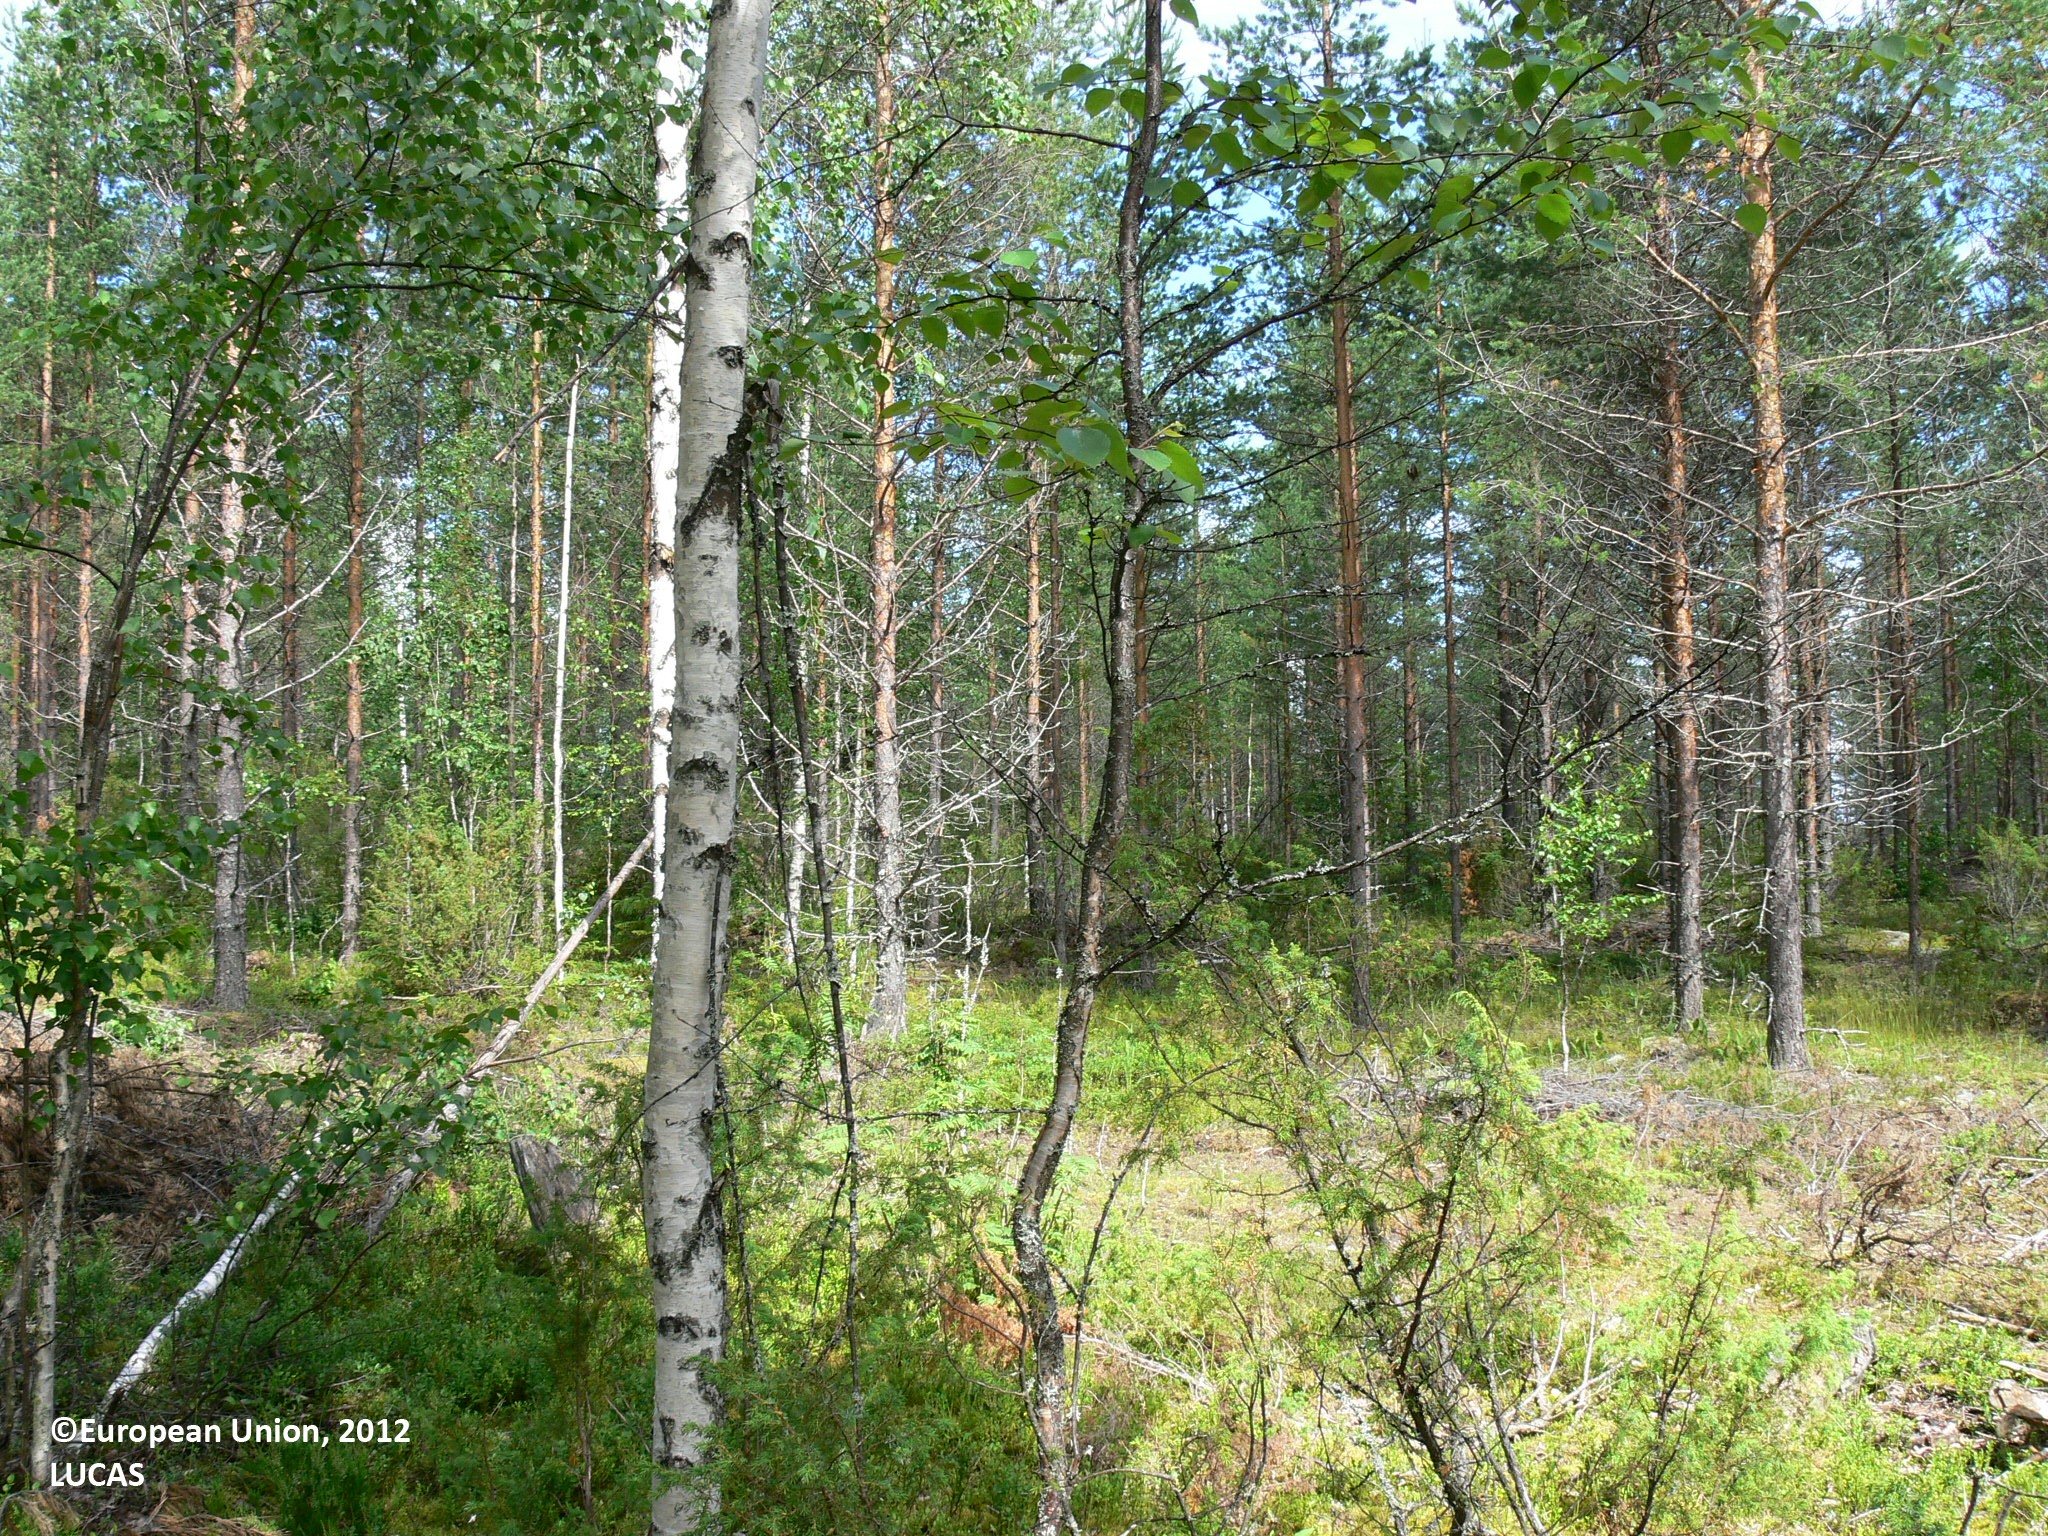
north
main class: Woodland
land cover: Pine dominated mixed woodland
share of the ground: 50 - 75 %
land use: Forestry
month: July
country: FI
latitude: 63.0380
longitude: 30.8730
